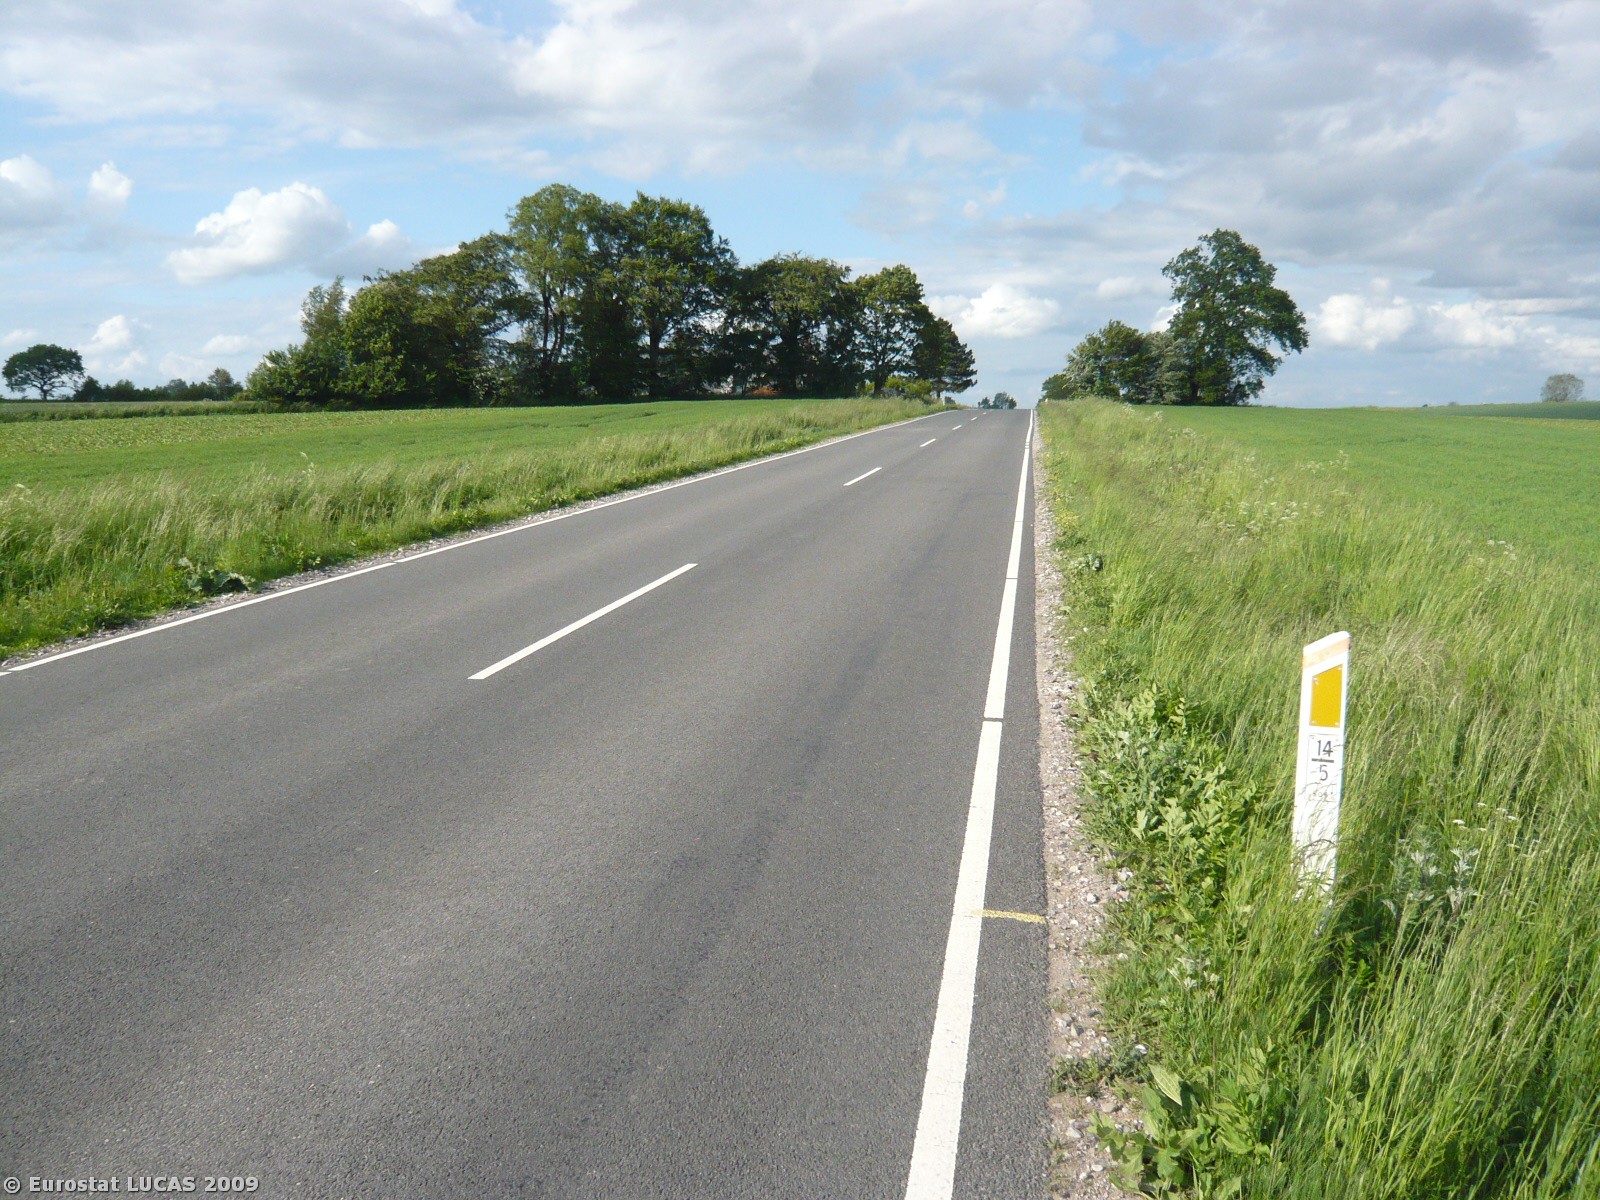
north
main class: Cropland
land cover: Sugar beet
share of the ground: 50 - 75 %
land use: Agriculture (excluding fallow land and kitchen gardens)
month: May
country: DK
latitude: 55.3161
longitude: 11.4957
